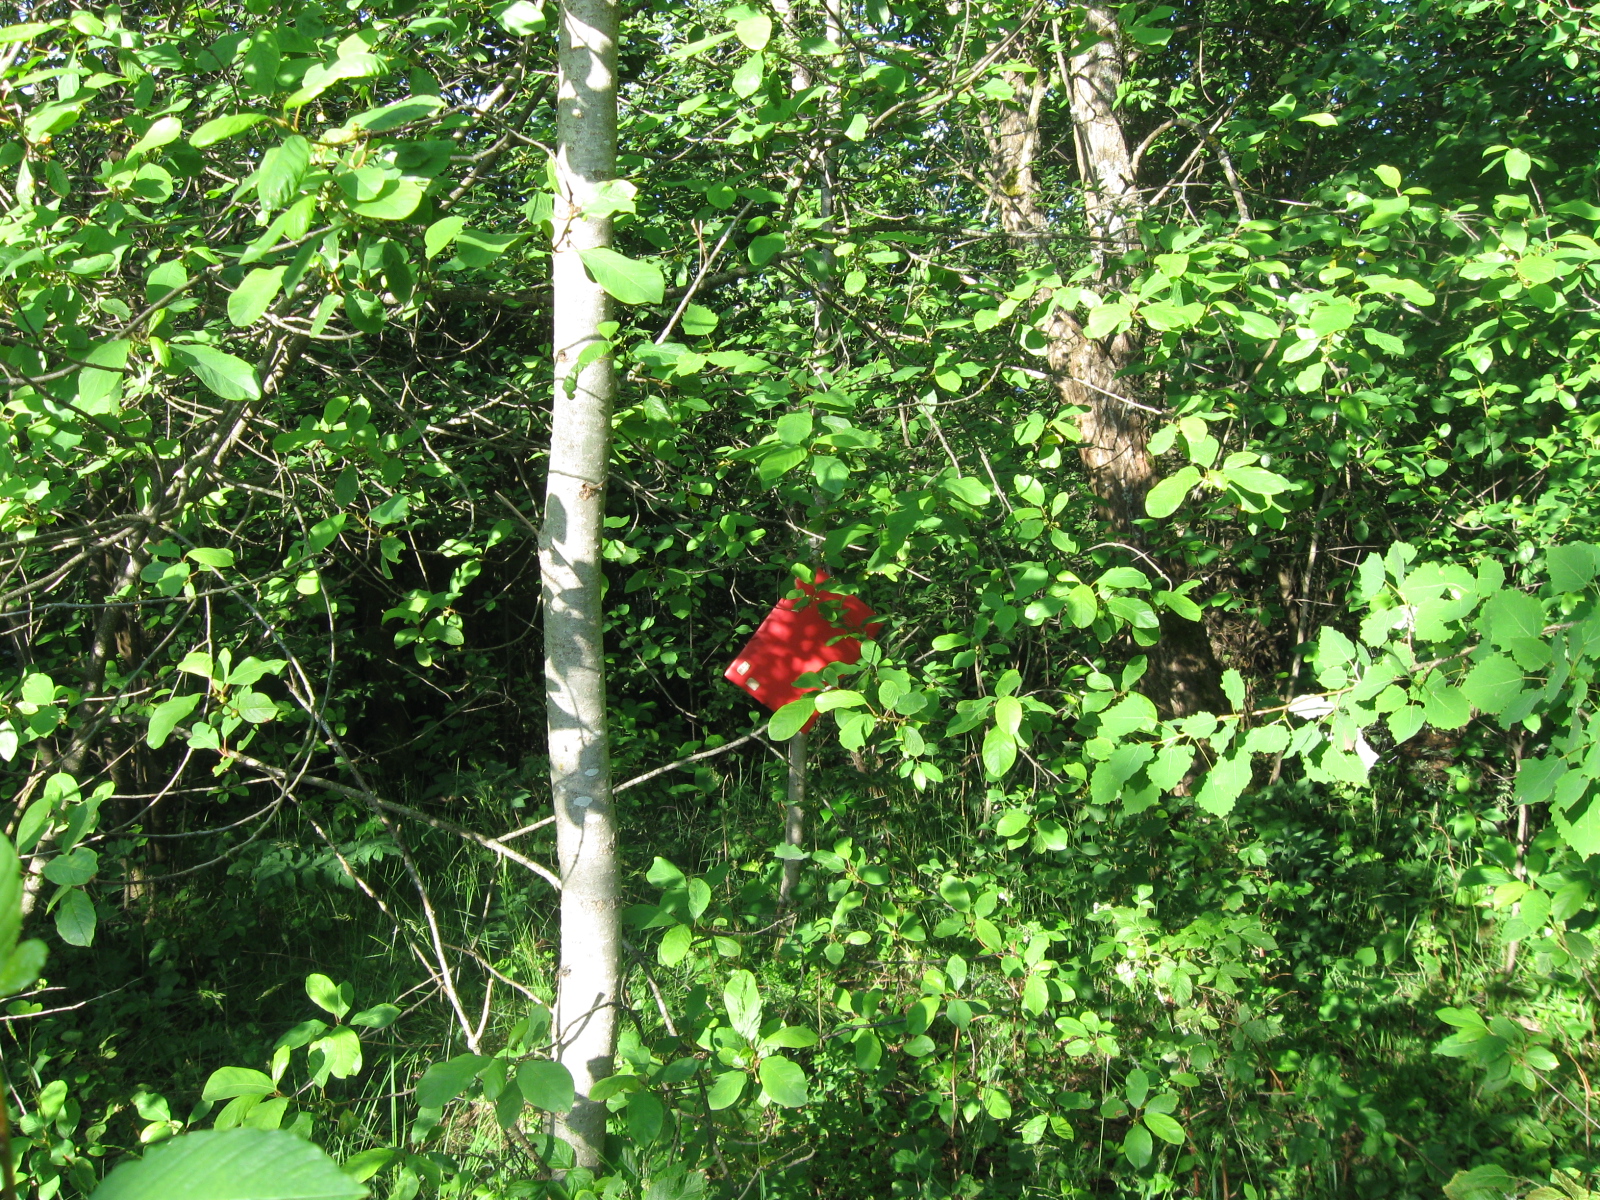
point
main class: Woodland
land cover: Broadleaved woodland
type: non-riverine alder, birch or aspen forest
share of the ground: > 75 %
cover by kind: broadleaved forest trees 95 %, herbaceous plants 5 %
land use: Forestry
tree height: > 5 m
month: June
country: LT
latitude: 54.1624
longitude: 24.7040
